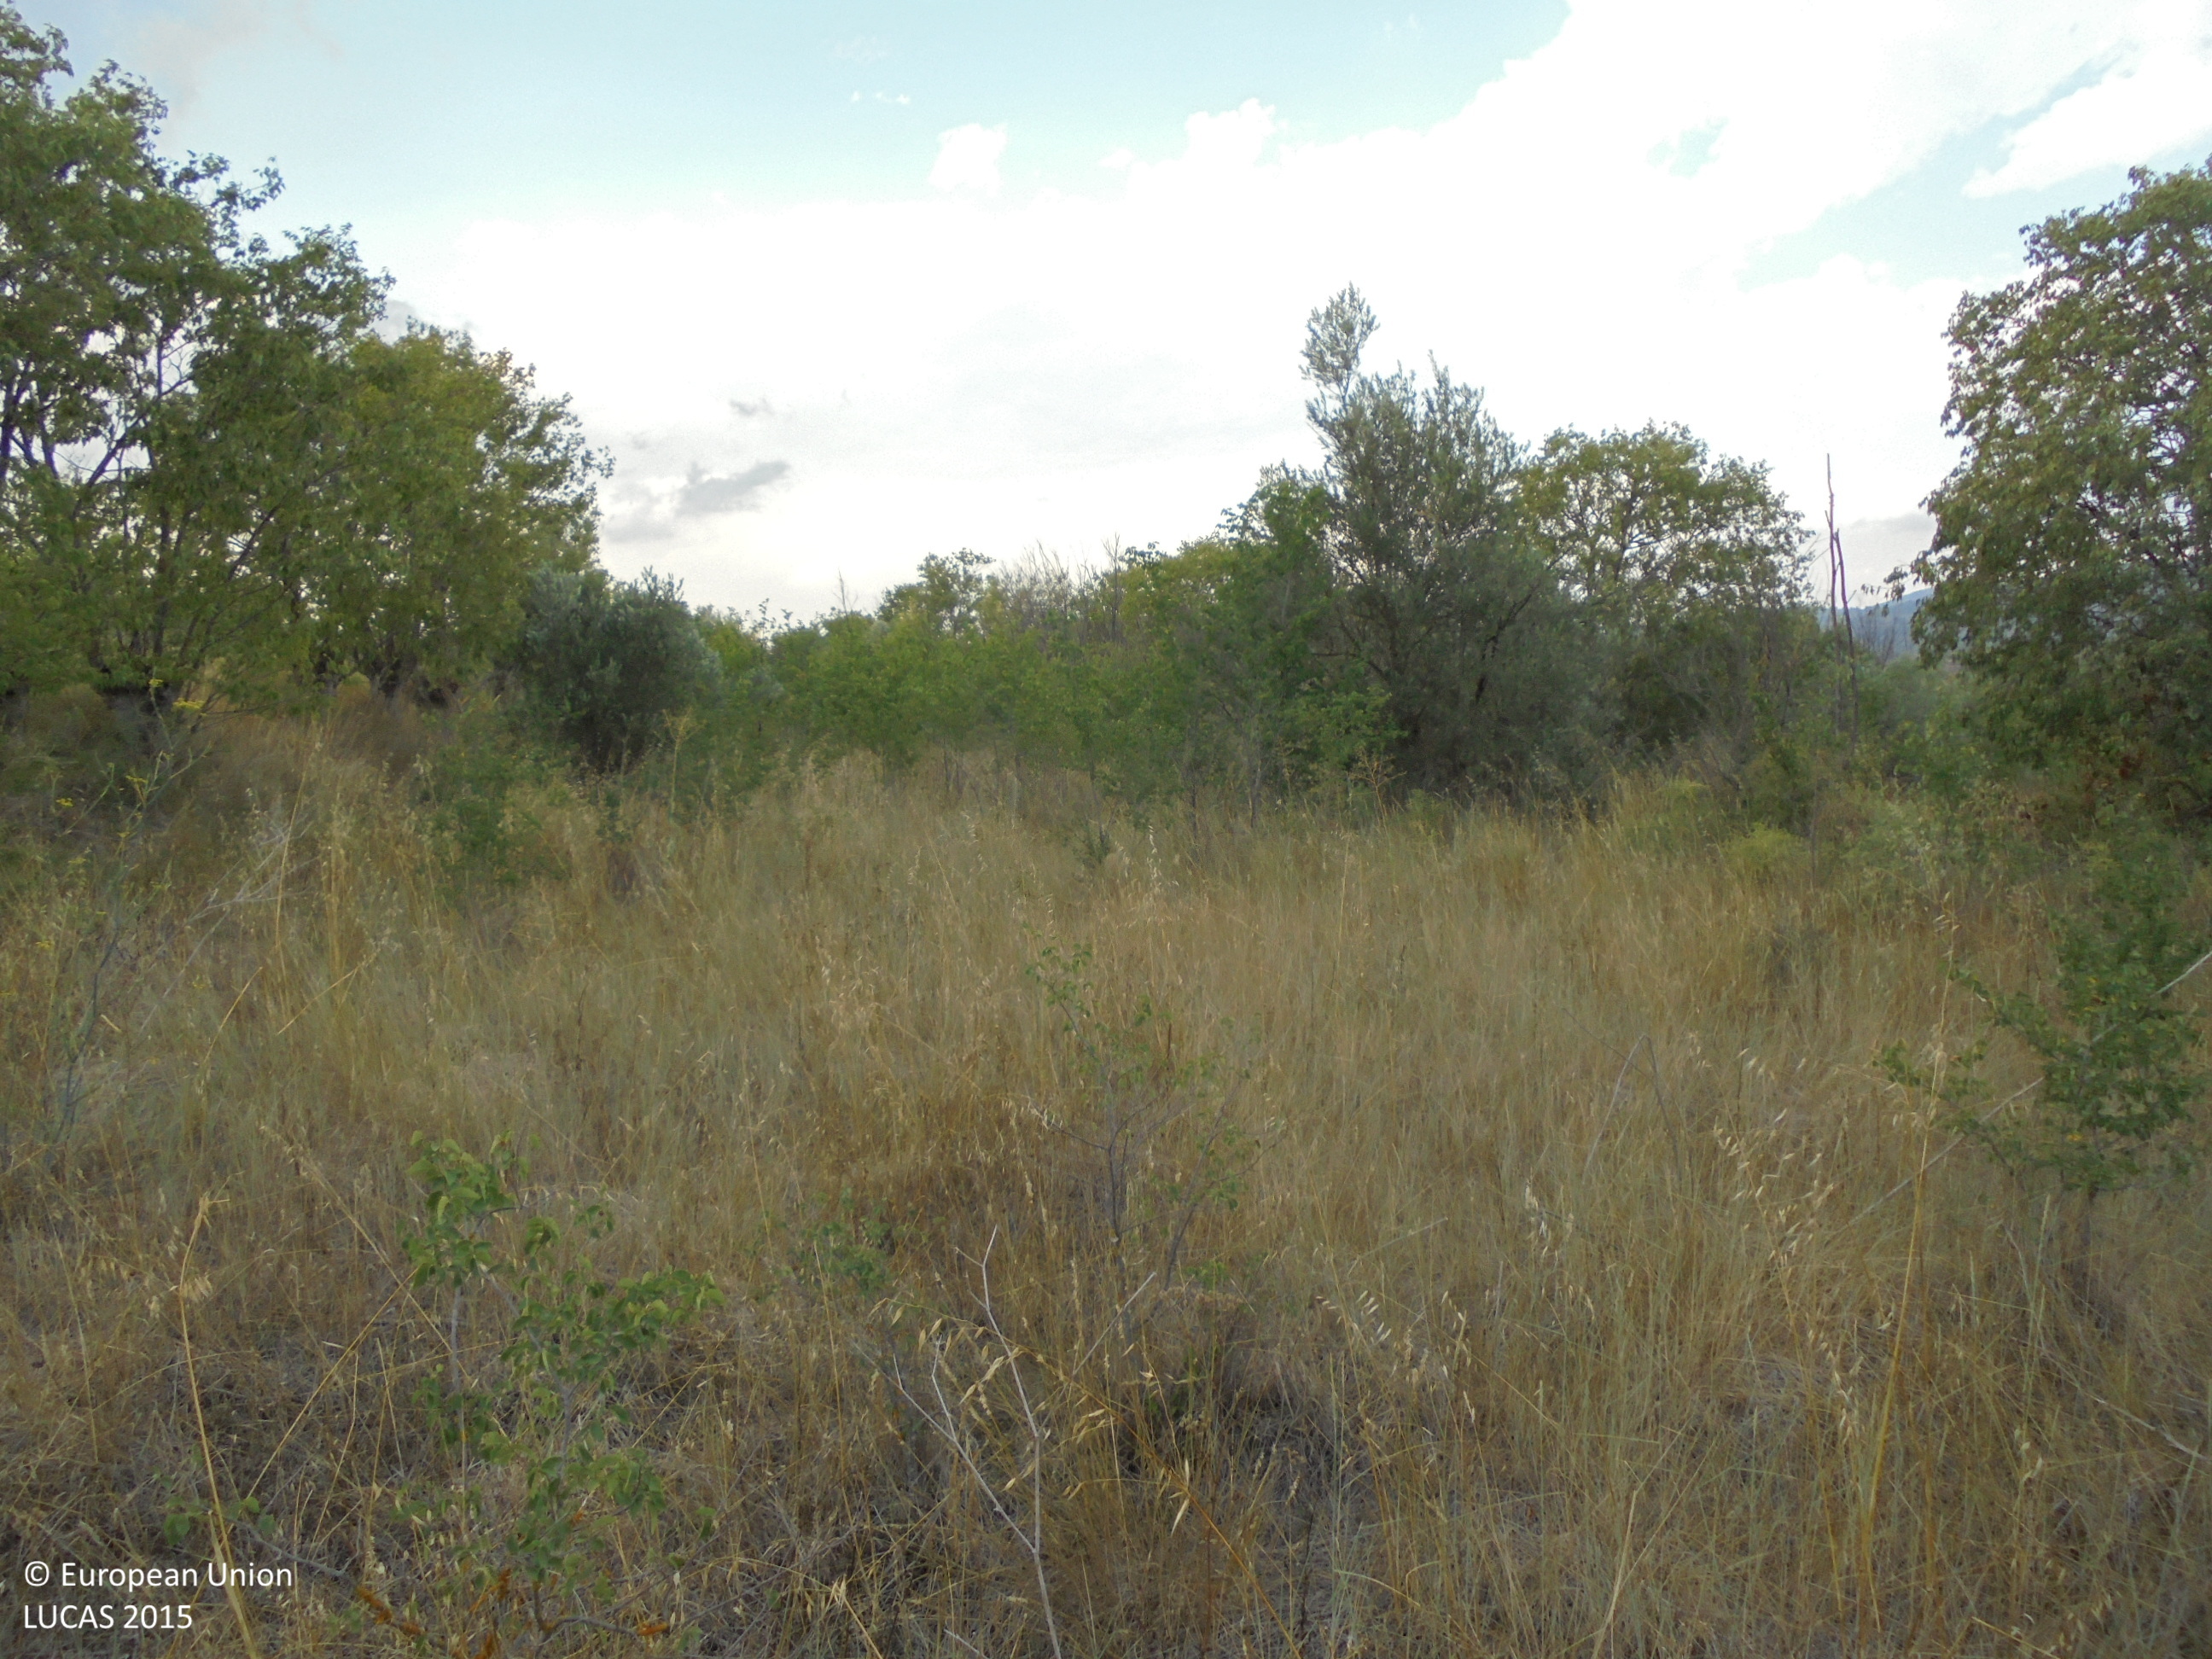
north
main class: Grassland
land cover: Grassland with sparse tree/shrub cover
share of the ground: > 75 %
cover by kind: herbaceous plants 95 %, broadleaved forest trees 5 %
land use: Abandoned areas
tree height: < 5 m
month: July
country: ES
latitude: 39.0949
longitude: -1.0383
